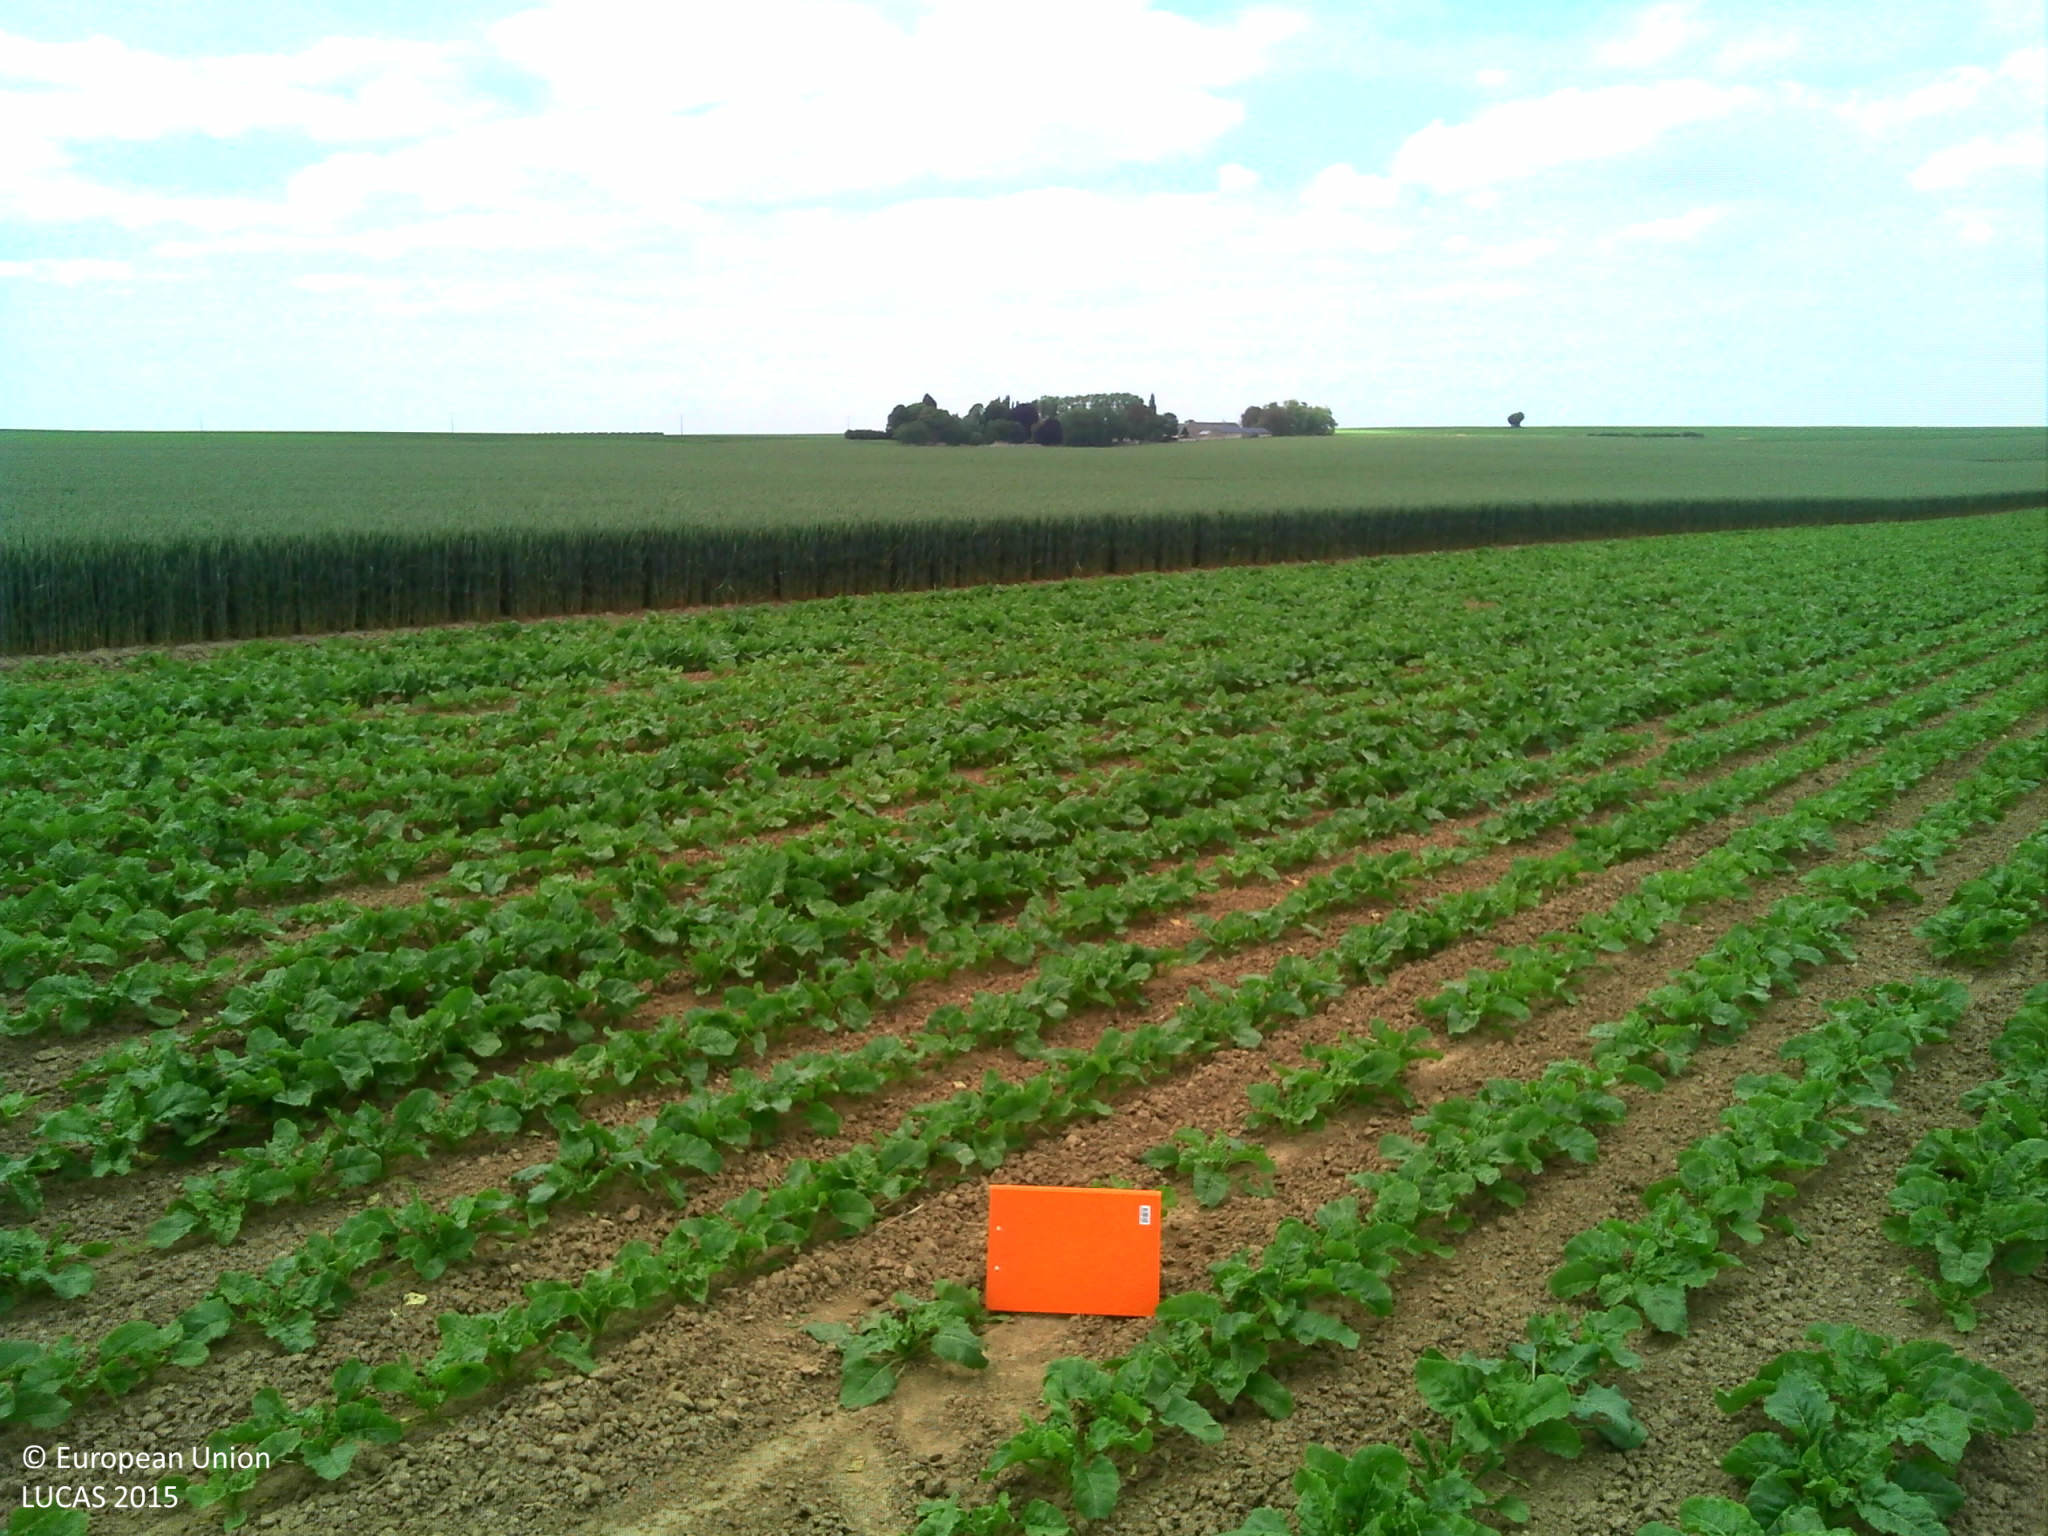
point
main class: Cropland
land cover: Sugar beet
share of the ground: 50 - 75 %
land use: Agriculture (excluding fallow land and kitchen gardens)
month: June
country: FR
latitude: 49.4784
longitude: 3.2426
